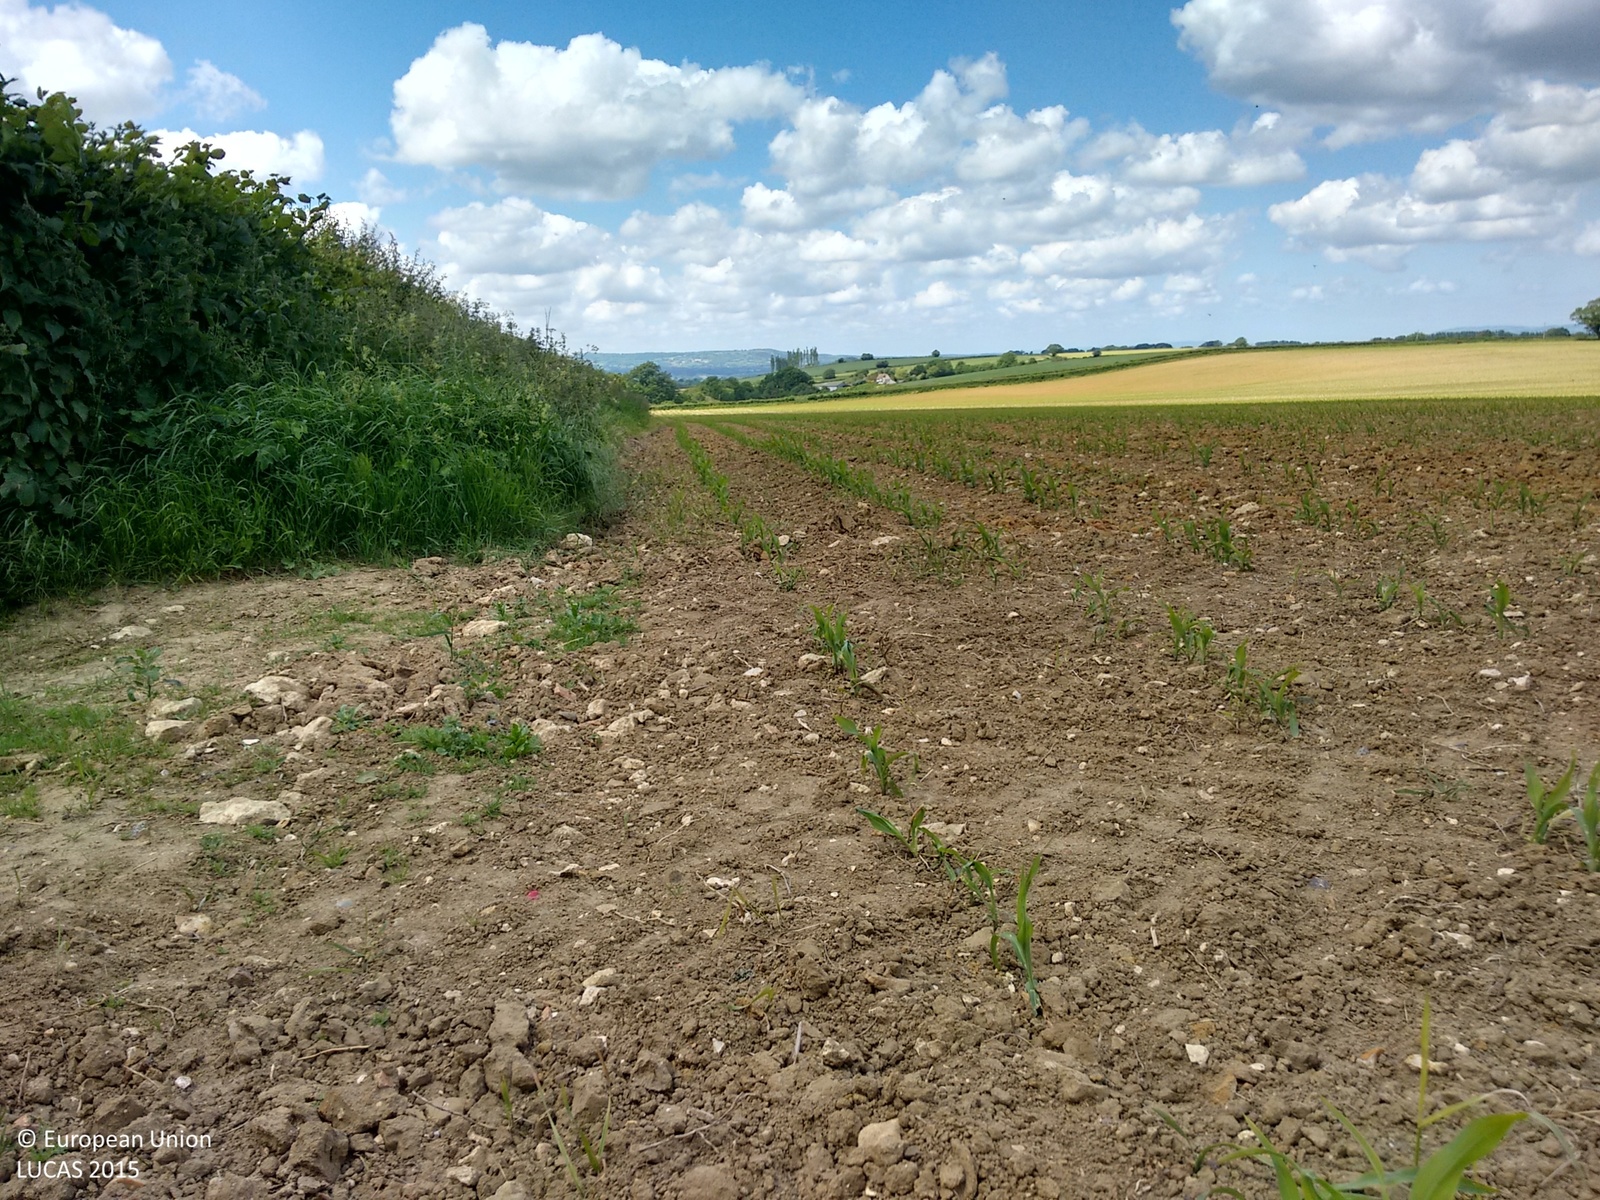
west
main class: Cropland
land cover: Maize
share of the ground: < 10 %
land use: Agriculture (excluding fallow land and kitchen gardens)
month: June
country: GB
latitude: 50.9095
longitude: -2.8579
